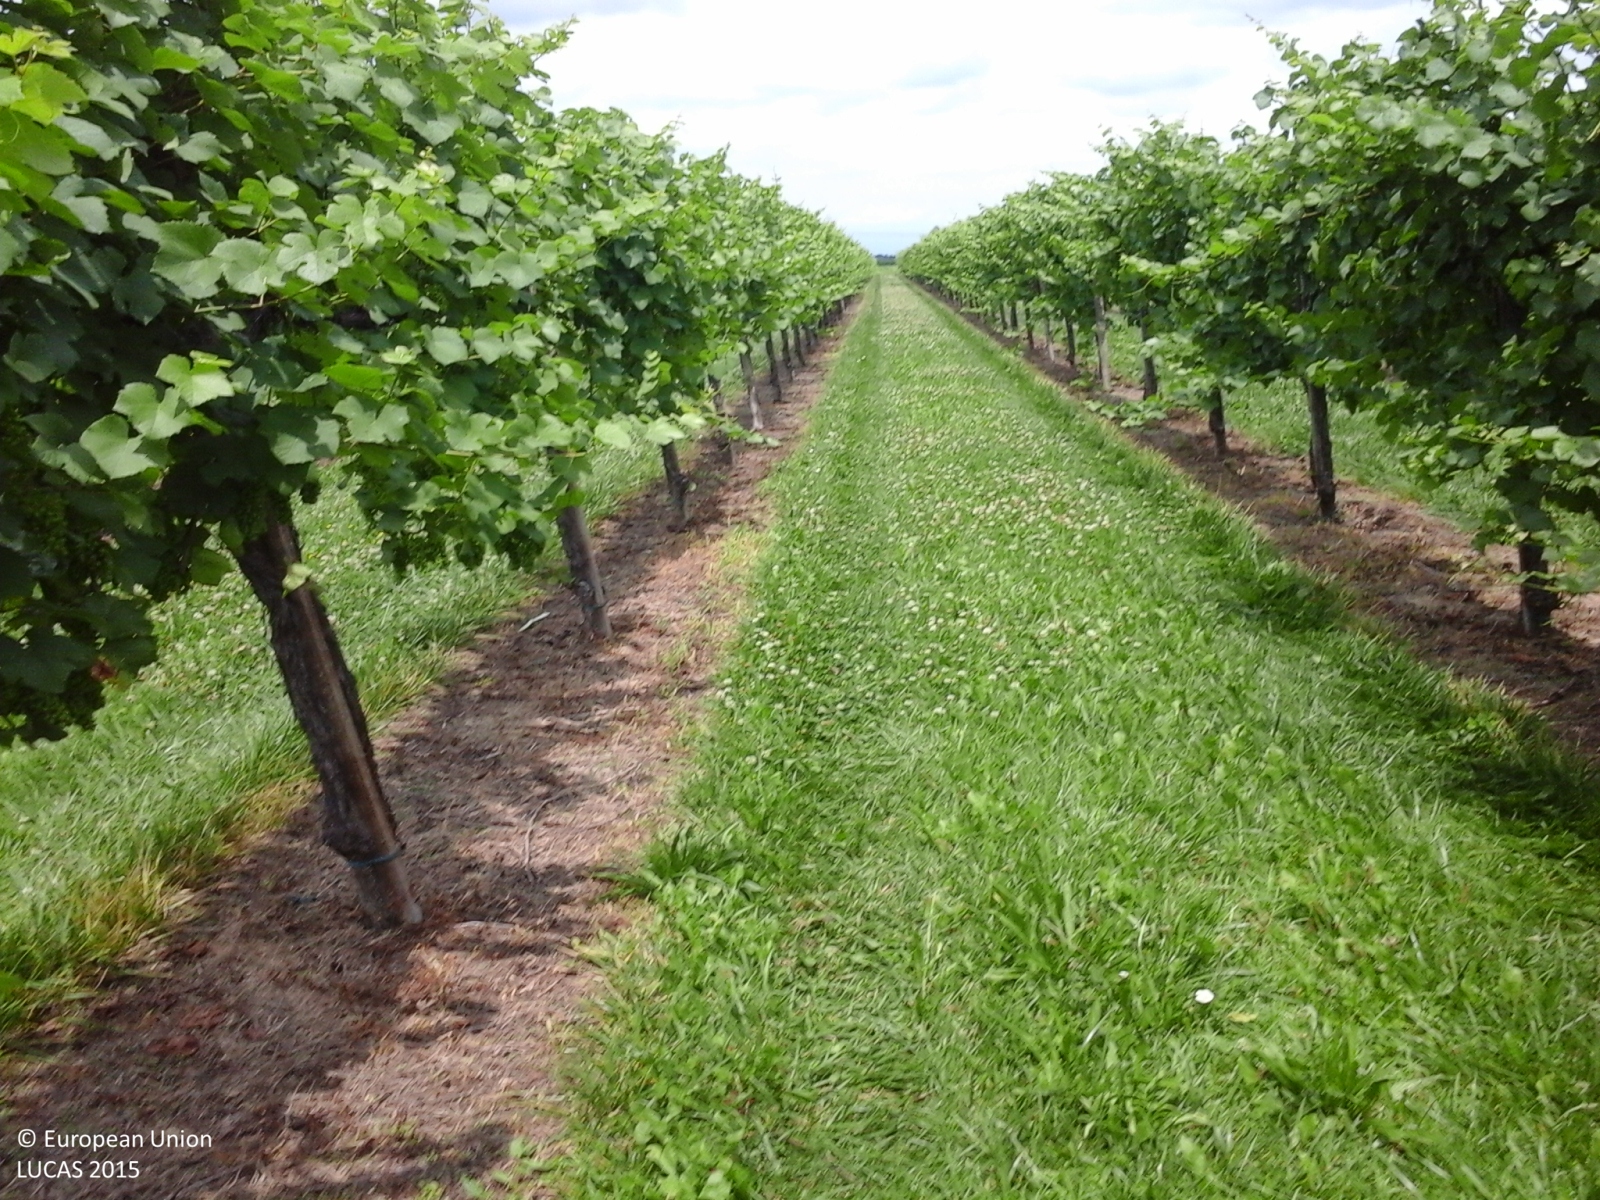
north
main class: Cropland
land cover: Vineyards
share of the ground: 25 - 50 %
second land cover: Grassland without tree/shrub cover
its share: > 75 %
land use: Agriculture (excluding fallow land and kitchen gardens)
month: June
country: IT
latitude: 45.7266
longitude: 12.5278
